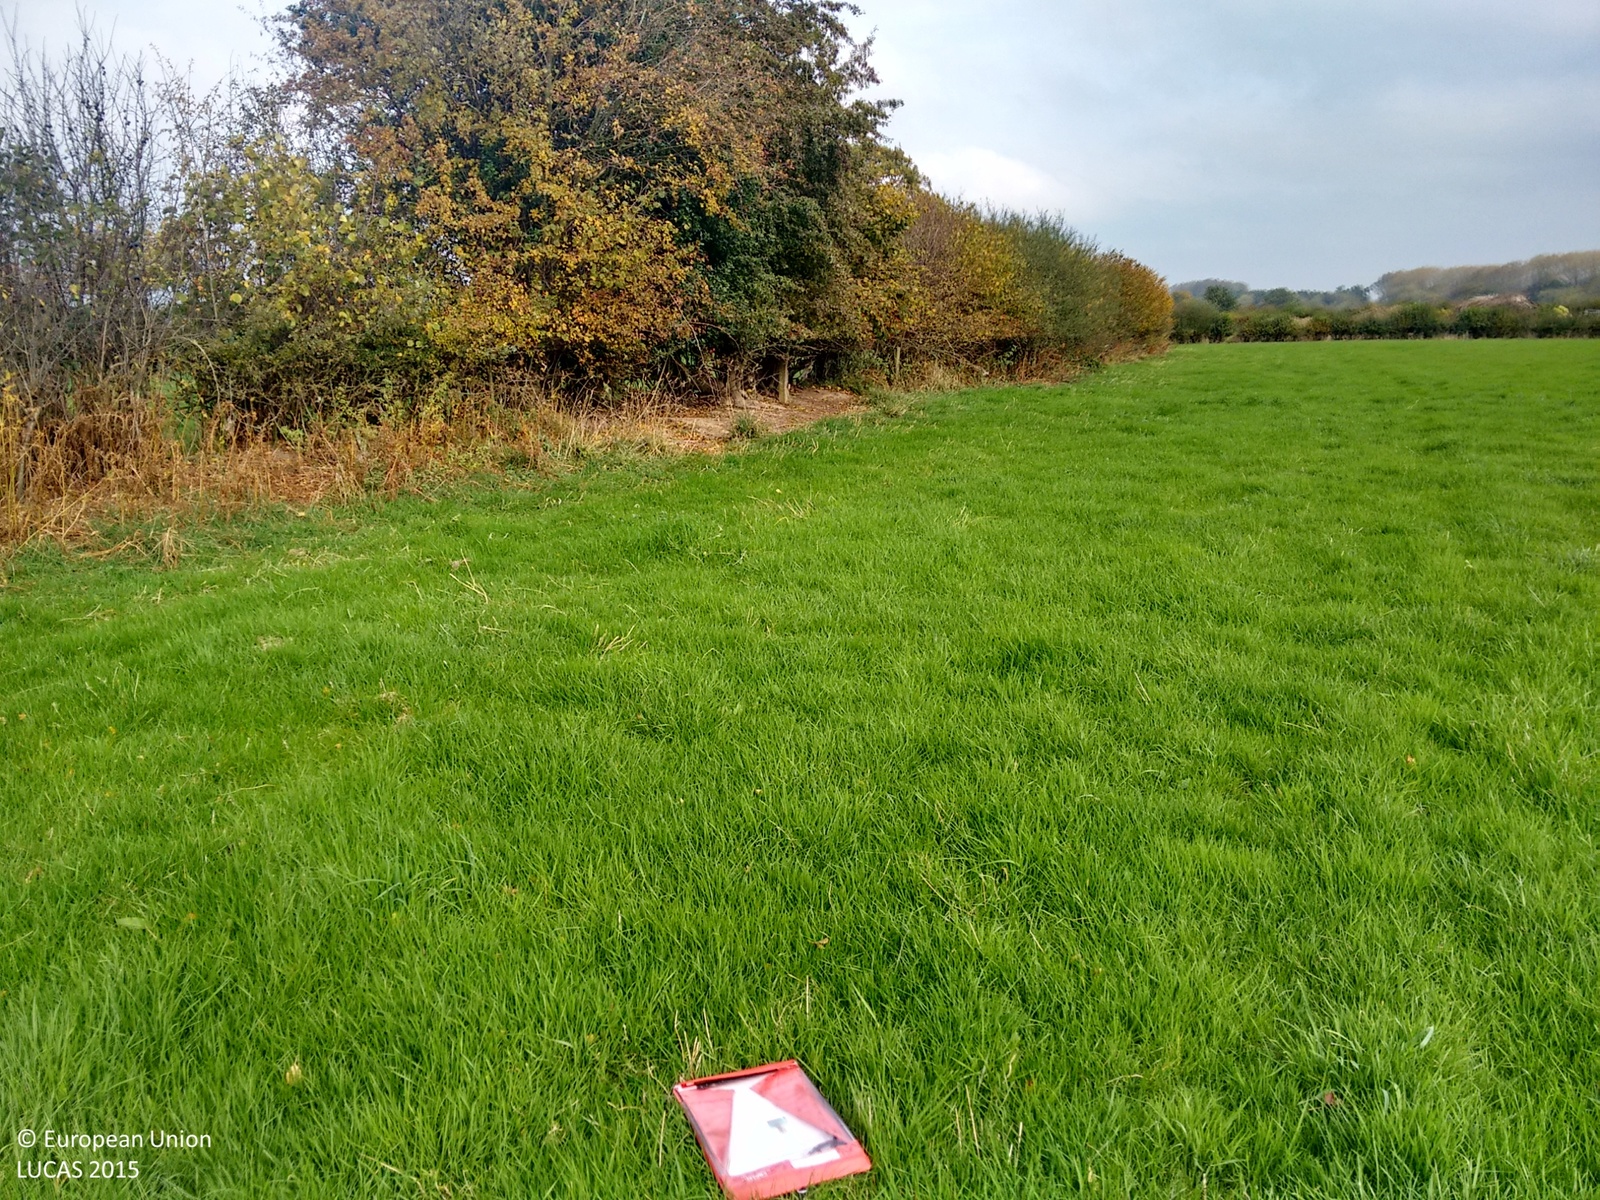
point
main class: Grassland
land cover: Grassland without tree/shrub cover
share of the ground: > 75 %
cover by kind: herbaceous plants 100 %
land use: Agriculture (excluding fallow land and kitchen gardens)
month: October
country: GB
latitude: 52.5936
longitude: -2.7813
